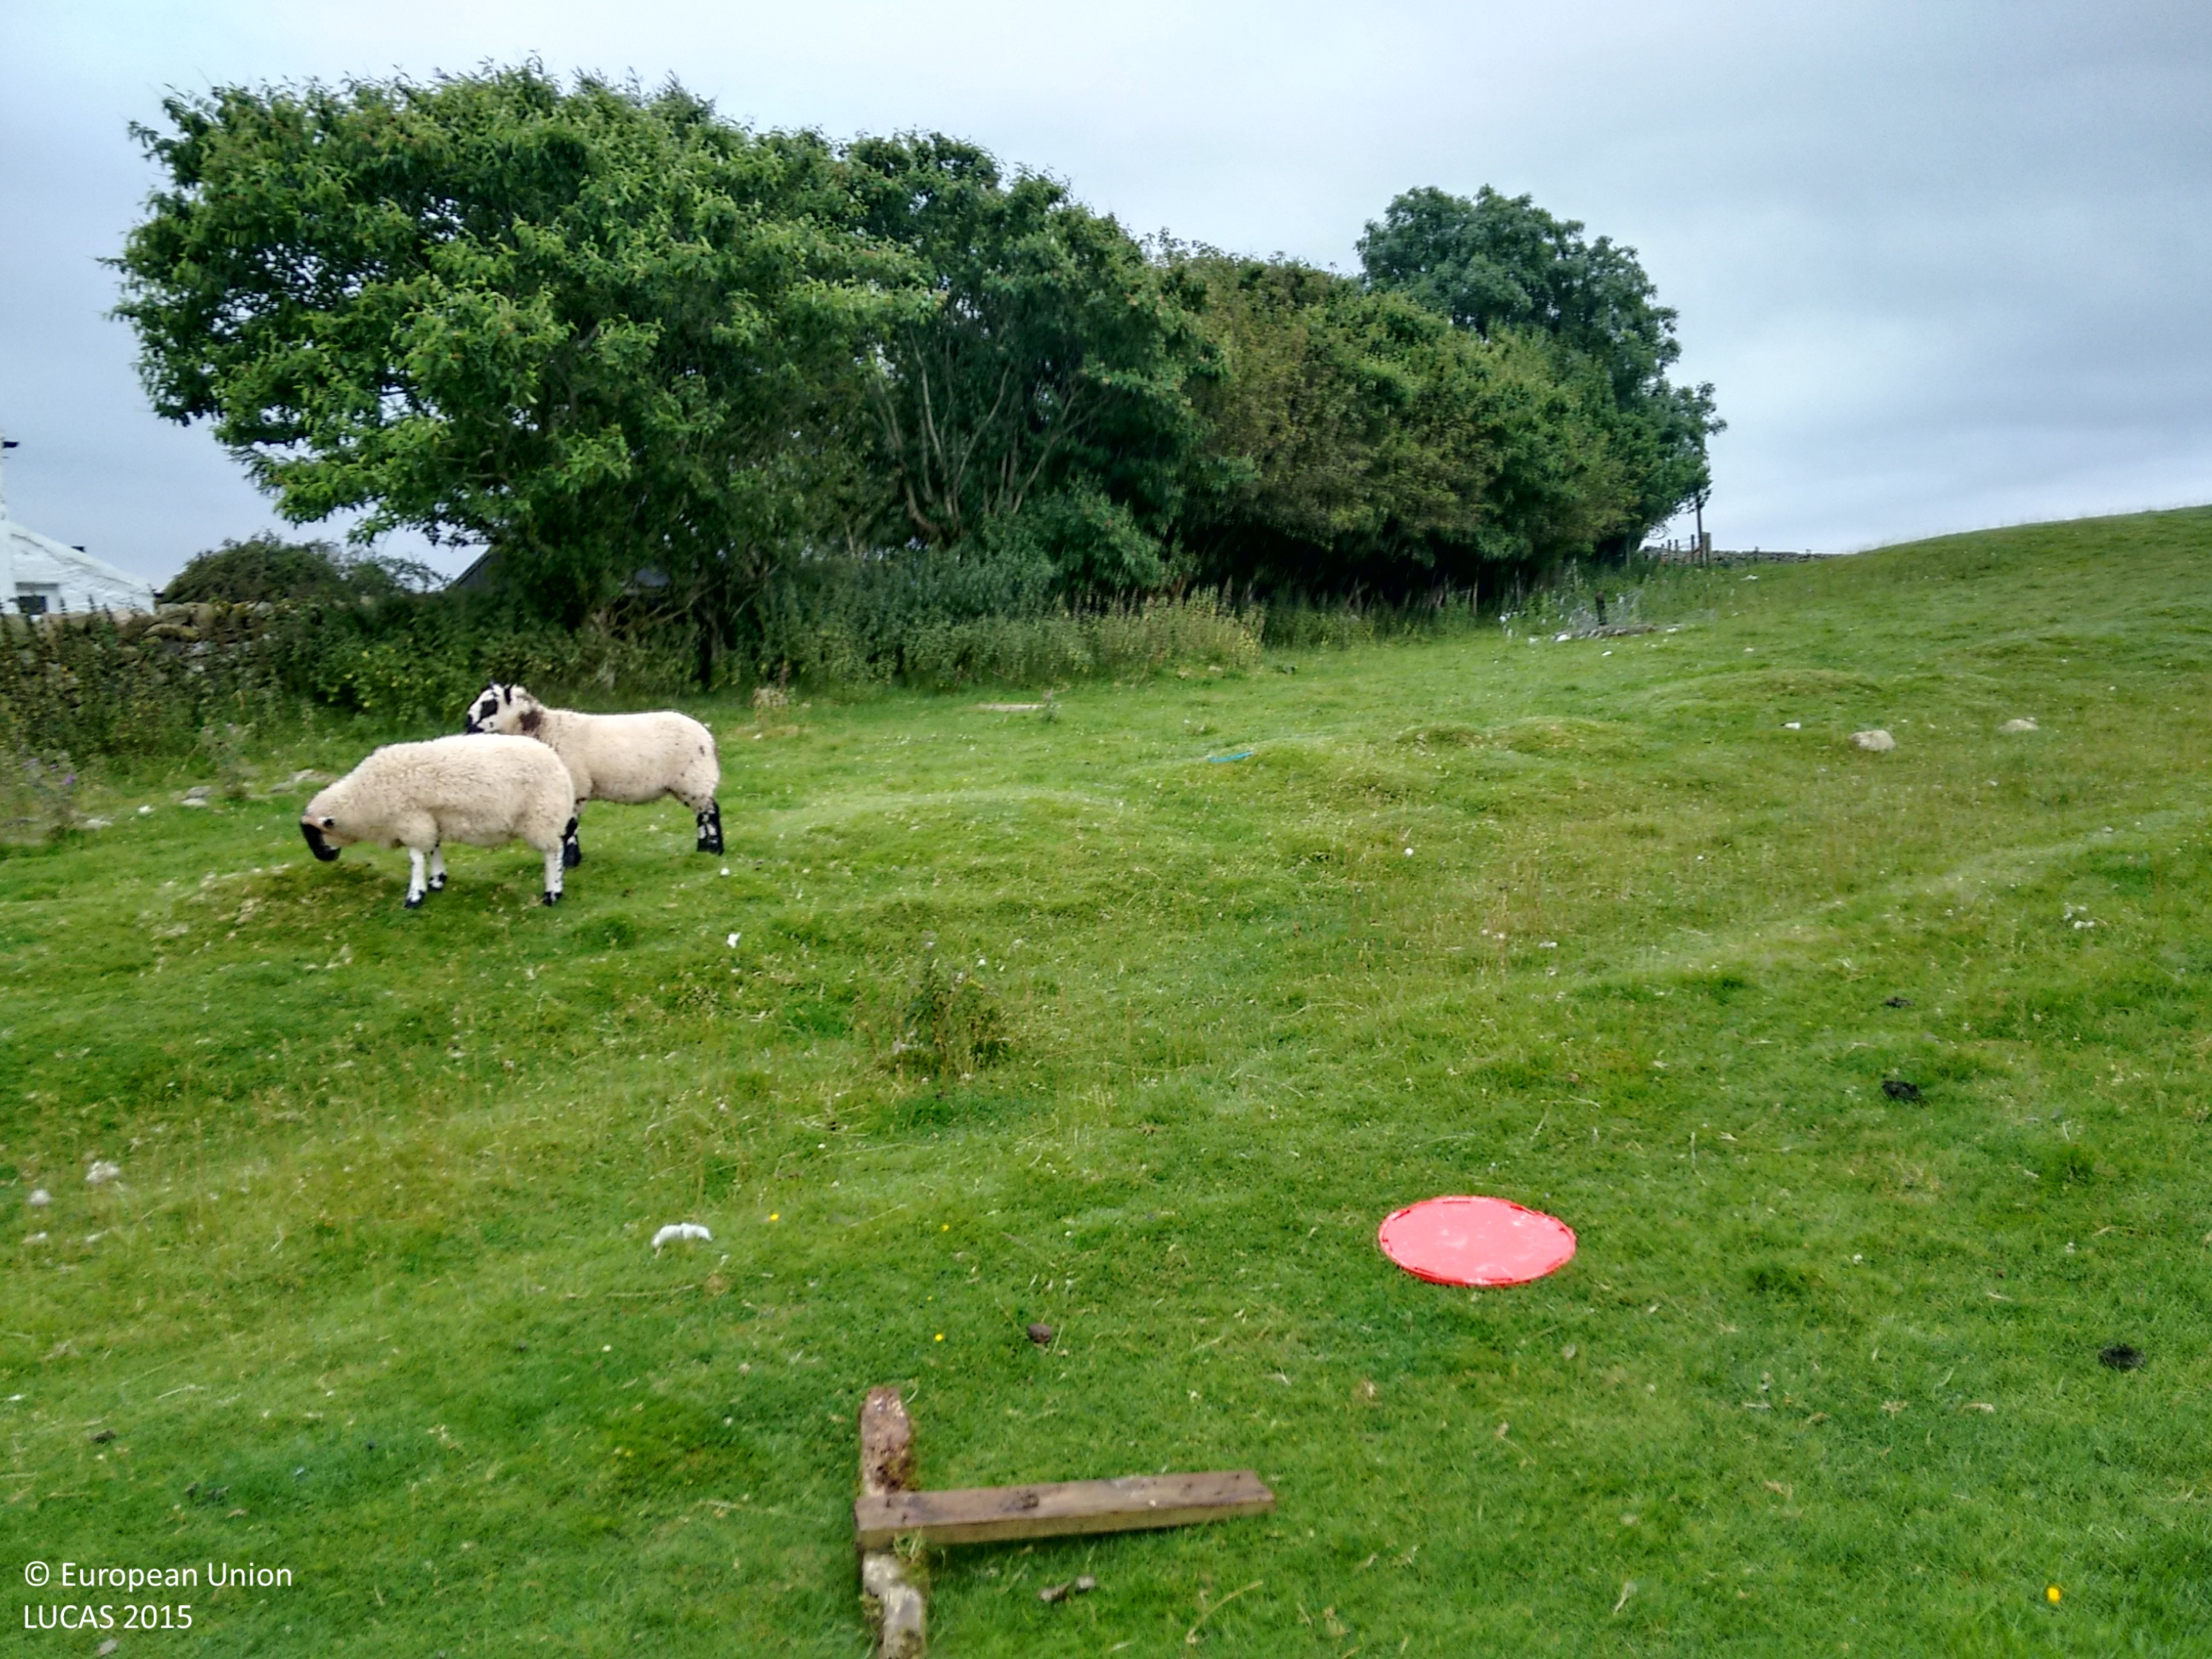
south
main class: Grassland
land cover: Grassland without tree/shrub cover
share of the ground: > 75 %
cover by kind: herbaceous plants 100 %
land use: Agriculture (excluding fallow land and kitchen gardens)
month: August
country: GB
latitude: 54.8932
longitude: -4.7163
